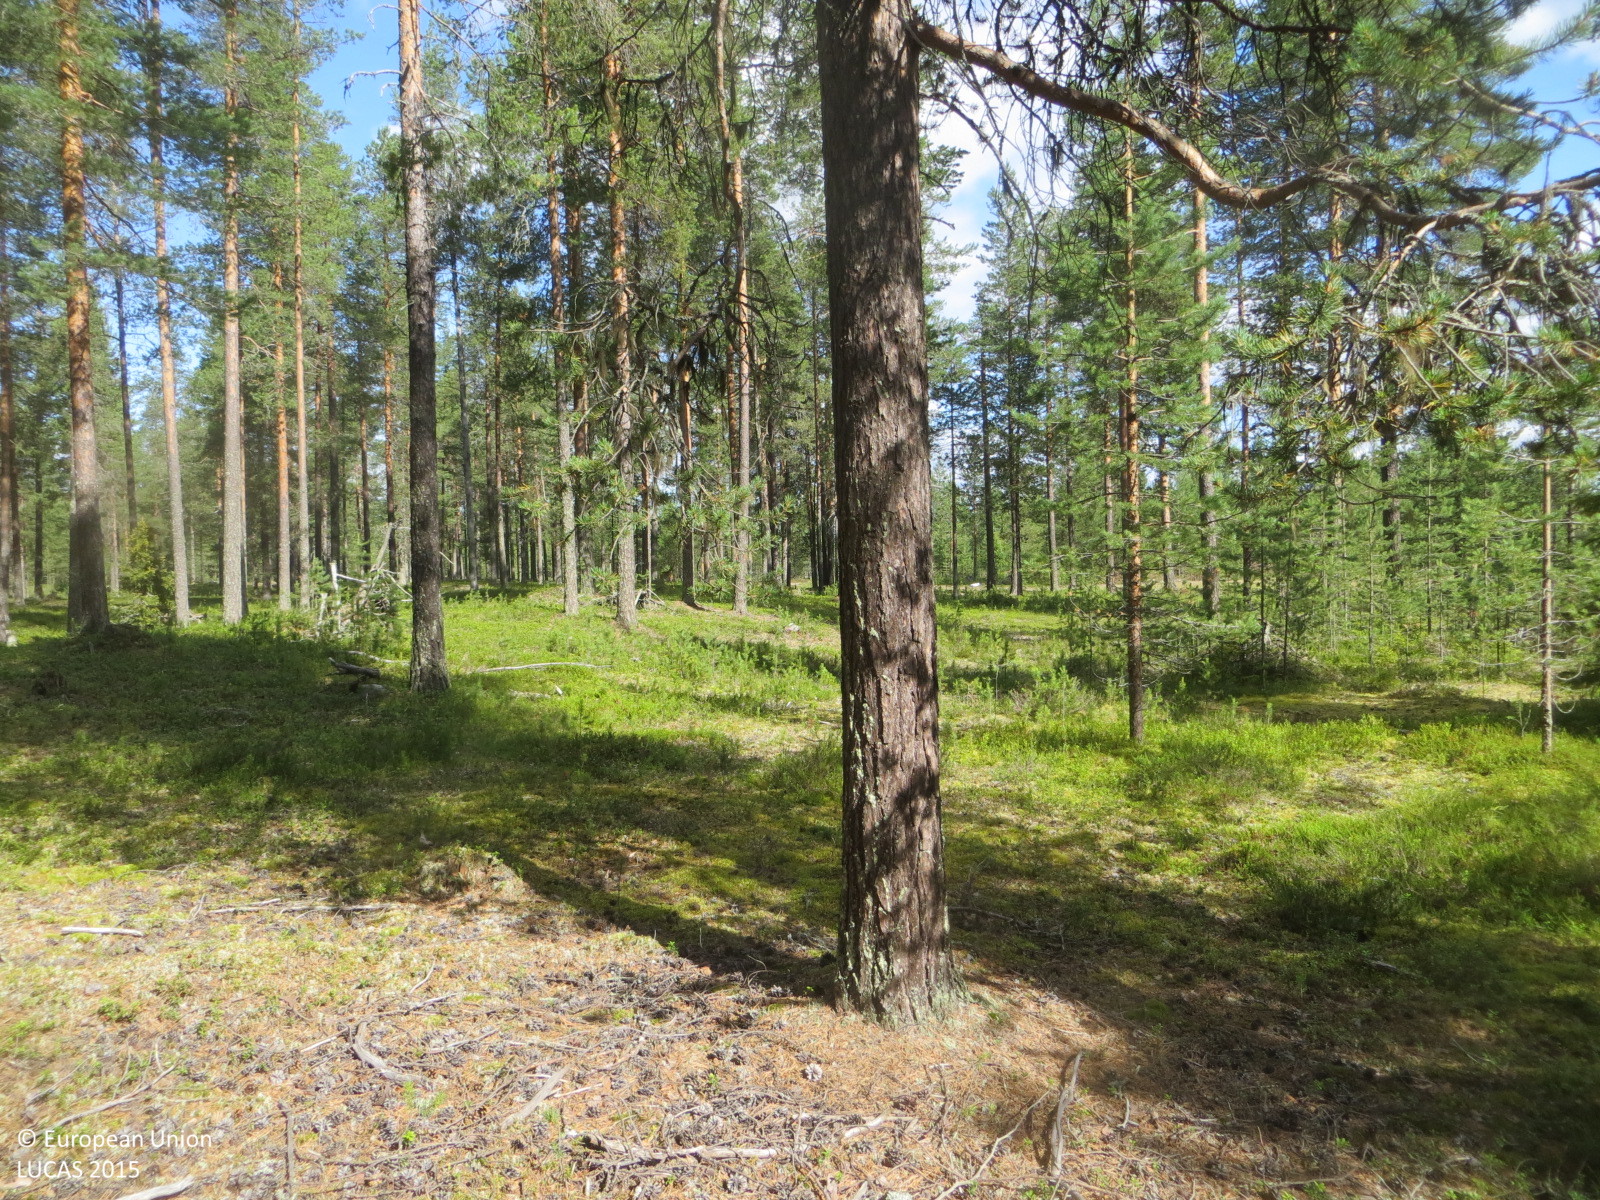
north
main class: Woodland
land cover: Pine dominated coniferous woodland
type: boreal forest
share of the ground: 50 - 75 %
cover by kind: coniferous forest trees 50 %, shrubs 50 %
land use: Forestry
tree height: > 5 m
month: August
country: FI
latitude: 66.4071
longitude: 25.4922
